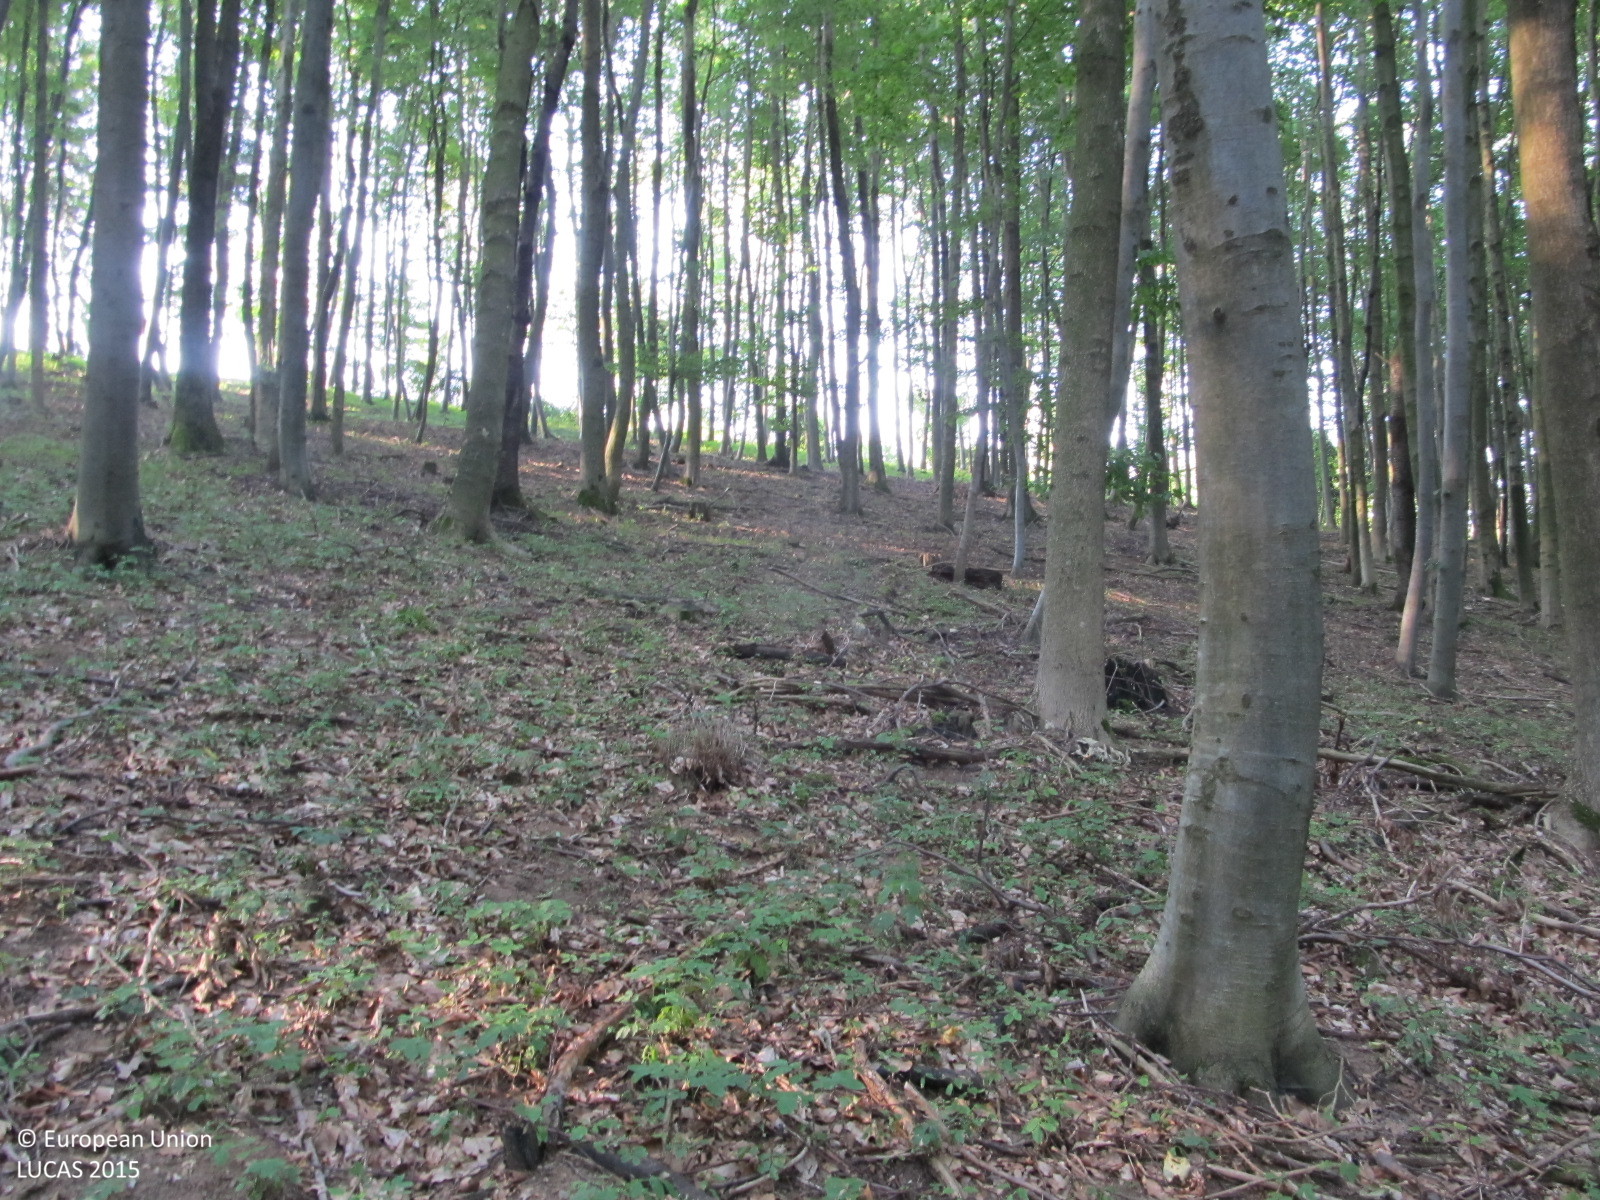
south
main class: Woodland
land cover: Broadleaved woodland
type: beech forest
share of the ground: > 75 %
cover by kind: broadleaved forest trees 80 %, unconsolidated bare surface 15 %, herbaceous plants 5 %
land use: Forestry
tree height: > 5 m
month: August
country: AT
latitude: 48.0906
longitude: 15.4126
